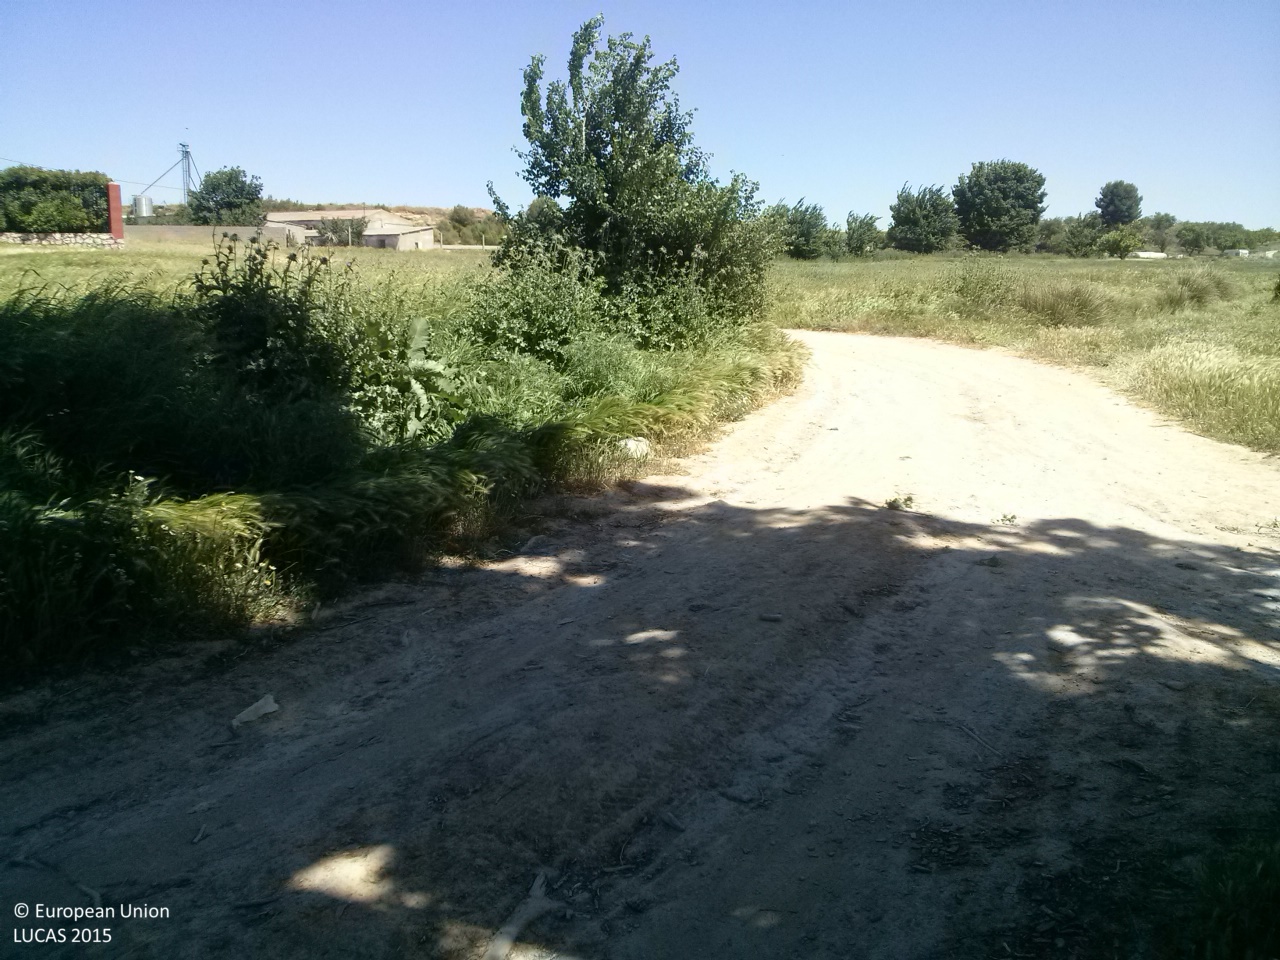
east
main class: Grassland
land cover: Grassland with sparse tree/shrub cover
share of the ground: 50 - 75 %
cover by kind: herbaceous plants 60 %, unconsolidated bare surface 35 %, broadleaved forest trees 5 %
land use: Abandoned areas
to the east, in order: Grassland with sparse tree/shrub cover; Barley; Grass margins; Tracks; Grass margins; Common wheat; Grass margins; Tracks; Grass margins; Fences; Artificial constructions in urban areas; Tracks; Grassland without tree/shrub cover; Tracks; Pine dominated coniferous woodland
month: May
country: ES
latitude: 40.3639
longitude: -2.7553
